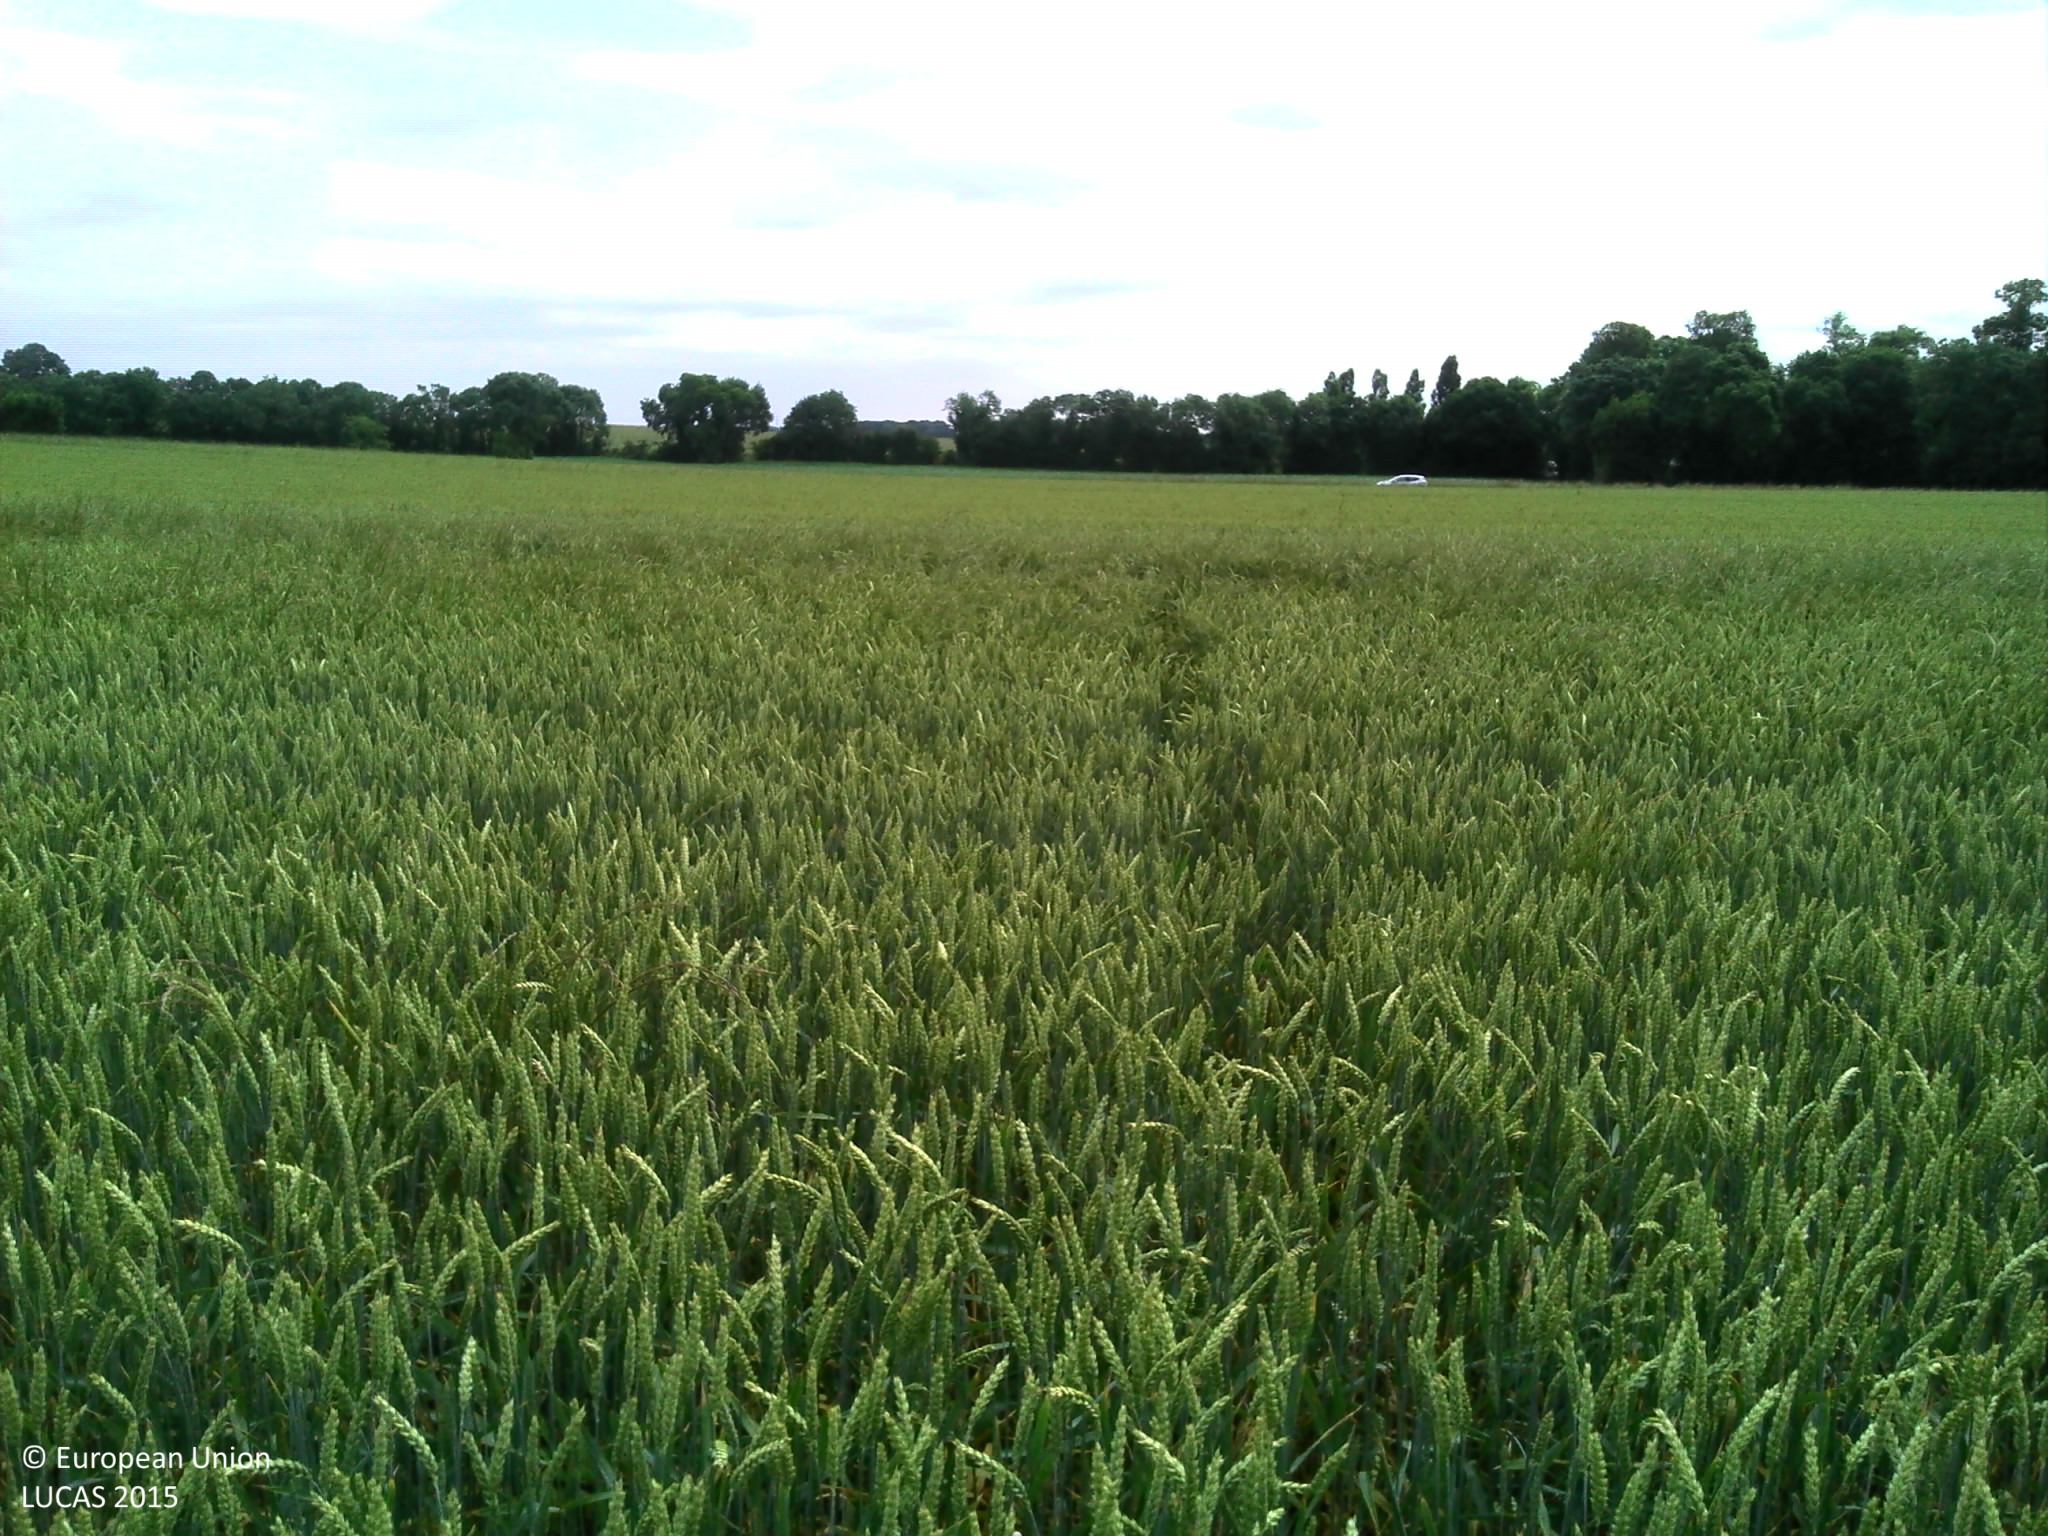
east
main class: Cropland
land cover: Common wheat
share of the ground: > 75 %
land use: Agriculture (excluding fallow land and kitchen gardens)
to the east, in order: Common wheat; Grass margins; Tracks; Grass margins; Maize
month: June
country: FR
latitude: 46.1690
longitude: -0.9481
